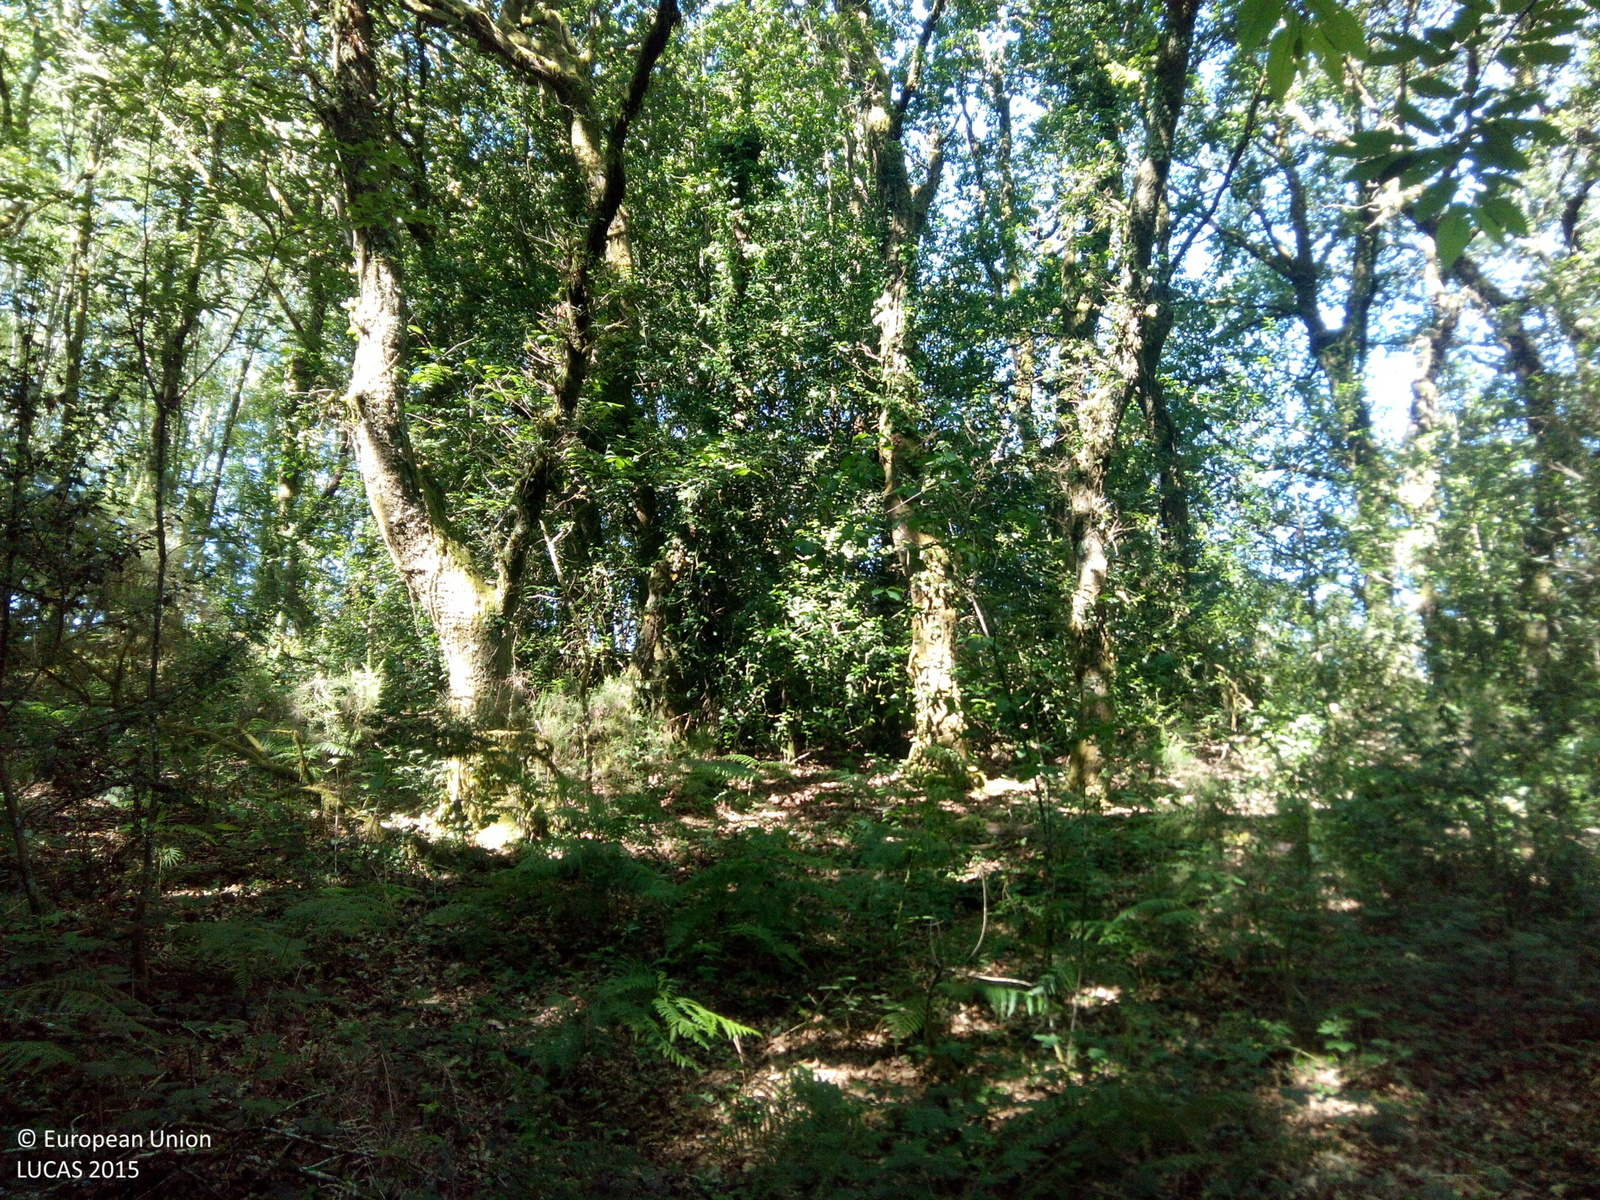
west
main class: Woodland
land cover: Broadleaved woodland
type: acidophilous oak and oak-birch forest
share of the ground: > 75 %
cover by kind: broadleaved forest trees 100 %
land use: Forestry
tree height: > 5 m
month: June
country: ES
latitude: 42.5186
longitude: -8.3145
